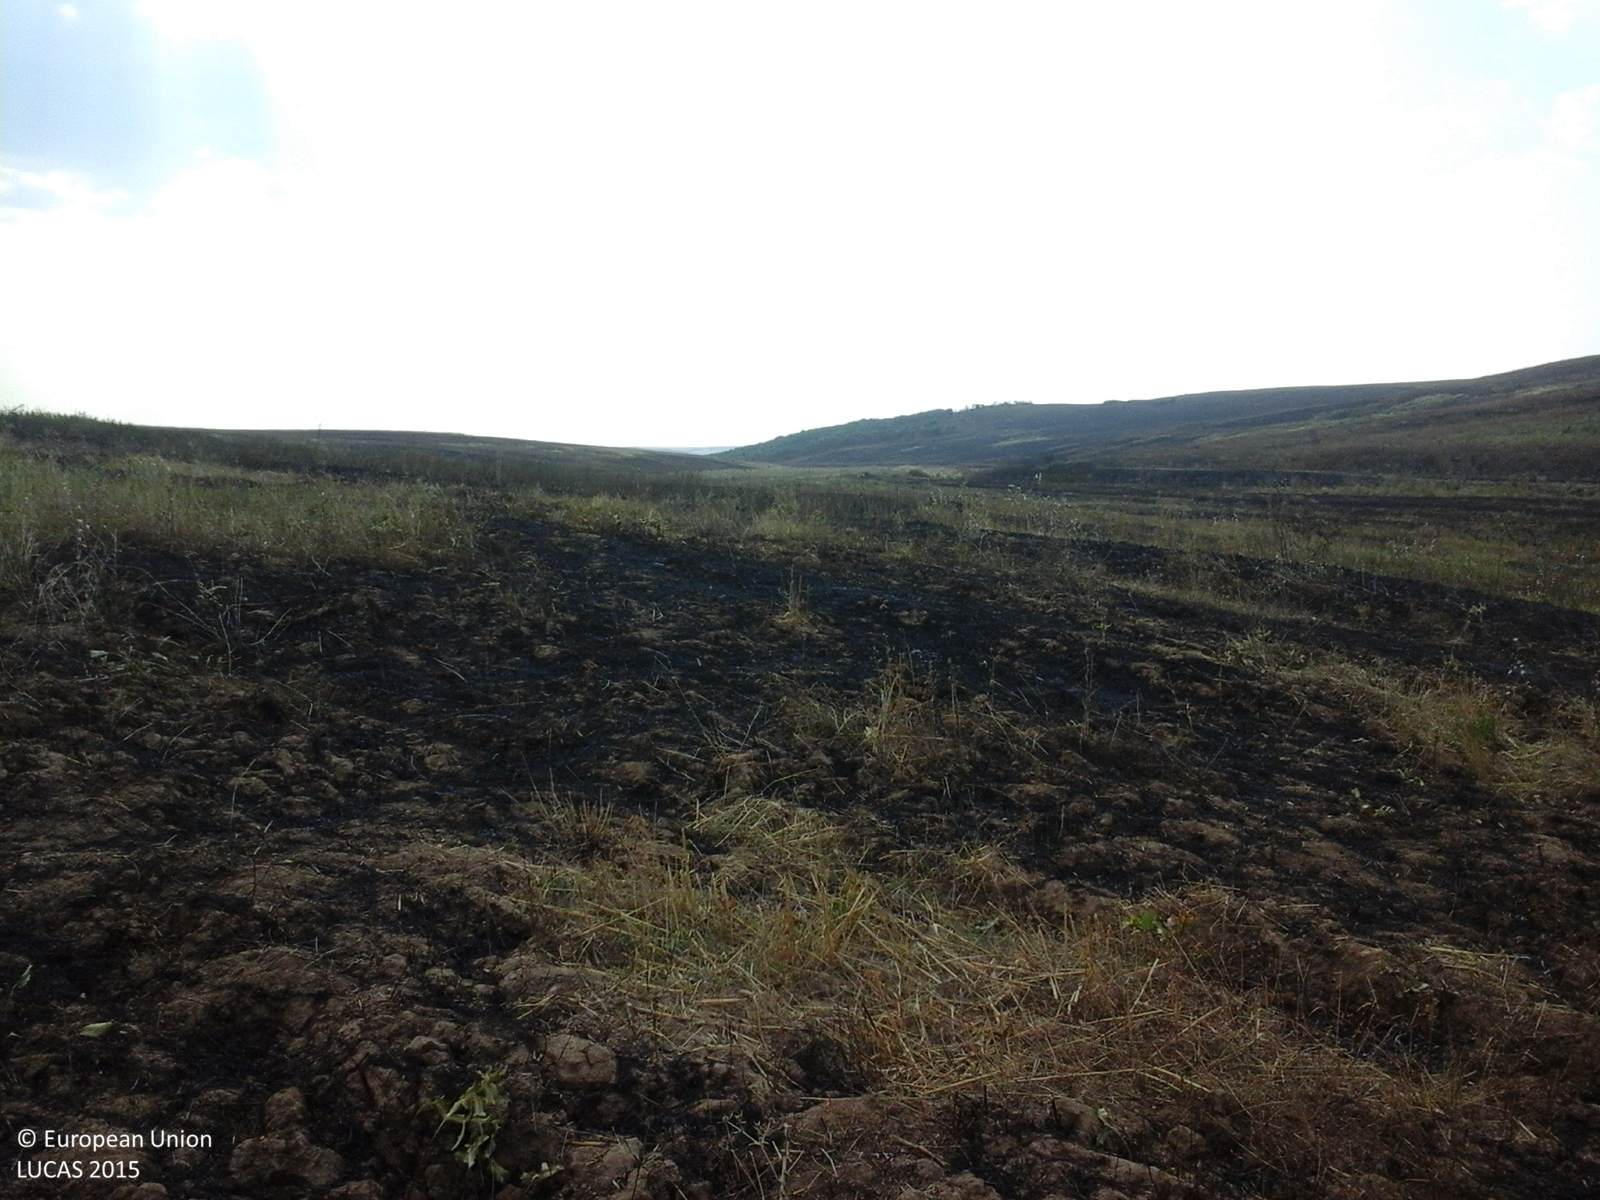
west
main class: Cropland
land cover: Durum wheat
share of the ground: 10 - 25 %
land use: Agriculture (excluding fallow land and kitchen gardens)
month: August
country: RO
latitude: 44.4529
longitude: 23.0526
